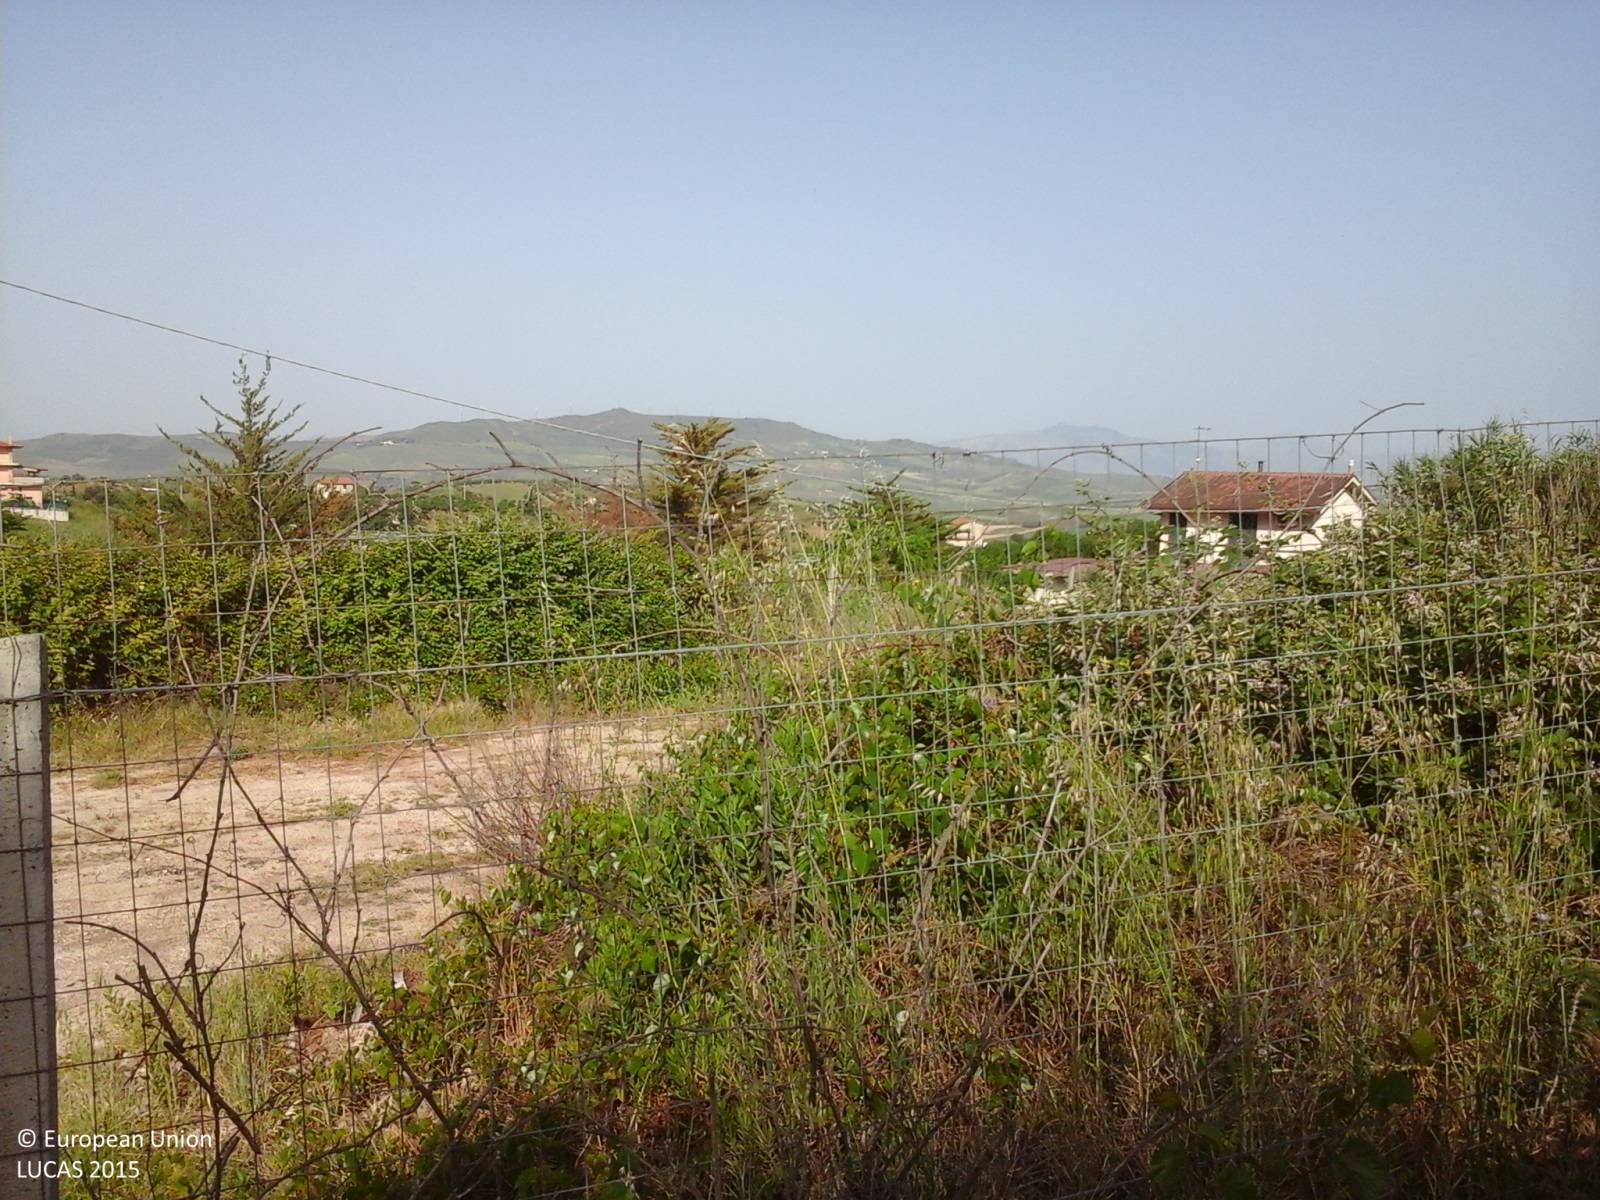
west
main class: Cropland
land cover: Olive groves
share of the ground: > 75 %
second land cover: Other bare soil
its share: > 75 %
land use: Agriculture (excluding fallow land and kitchen gardens)
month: May
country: IT
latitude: 37.9670
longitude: 13.1758
